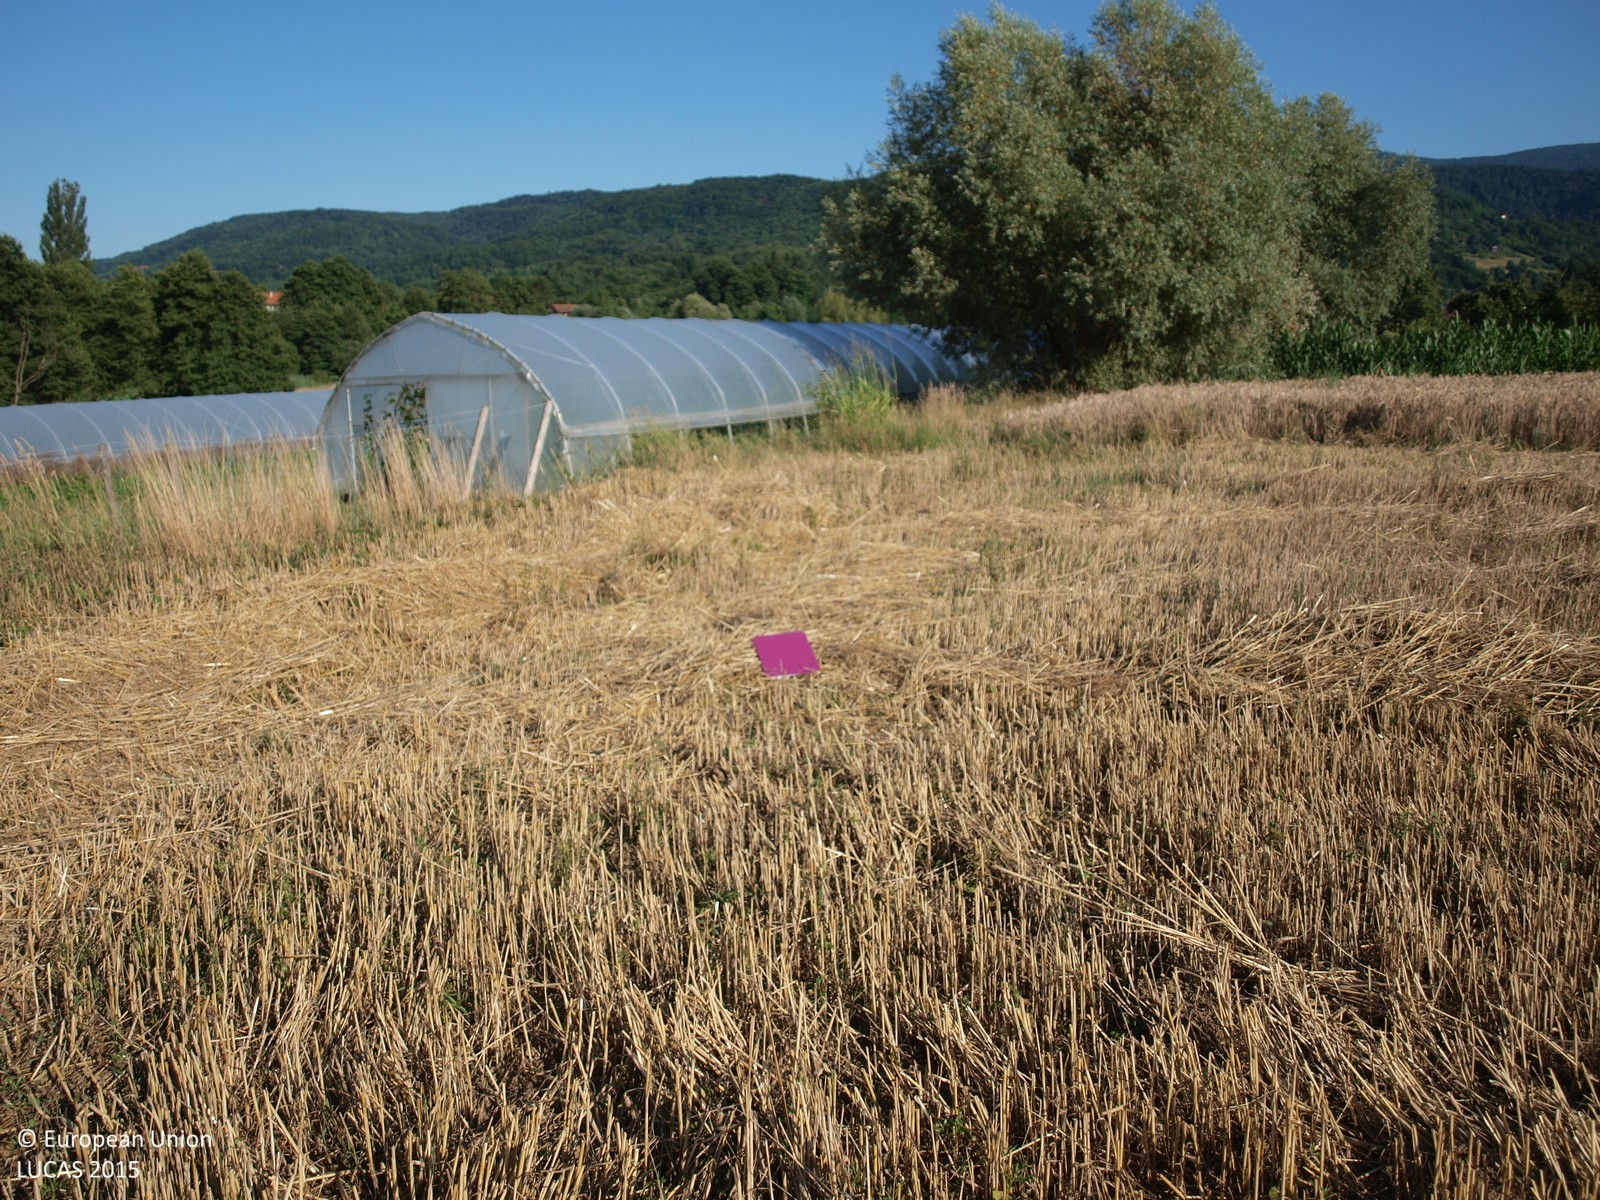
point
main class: Cropland
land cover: Barley
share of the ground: > 75 %
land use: Agriculture (excluding fallow land and kitchen gardens)
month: July
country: HR
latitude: 45.9675
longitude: 15.9733
